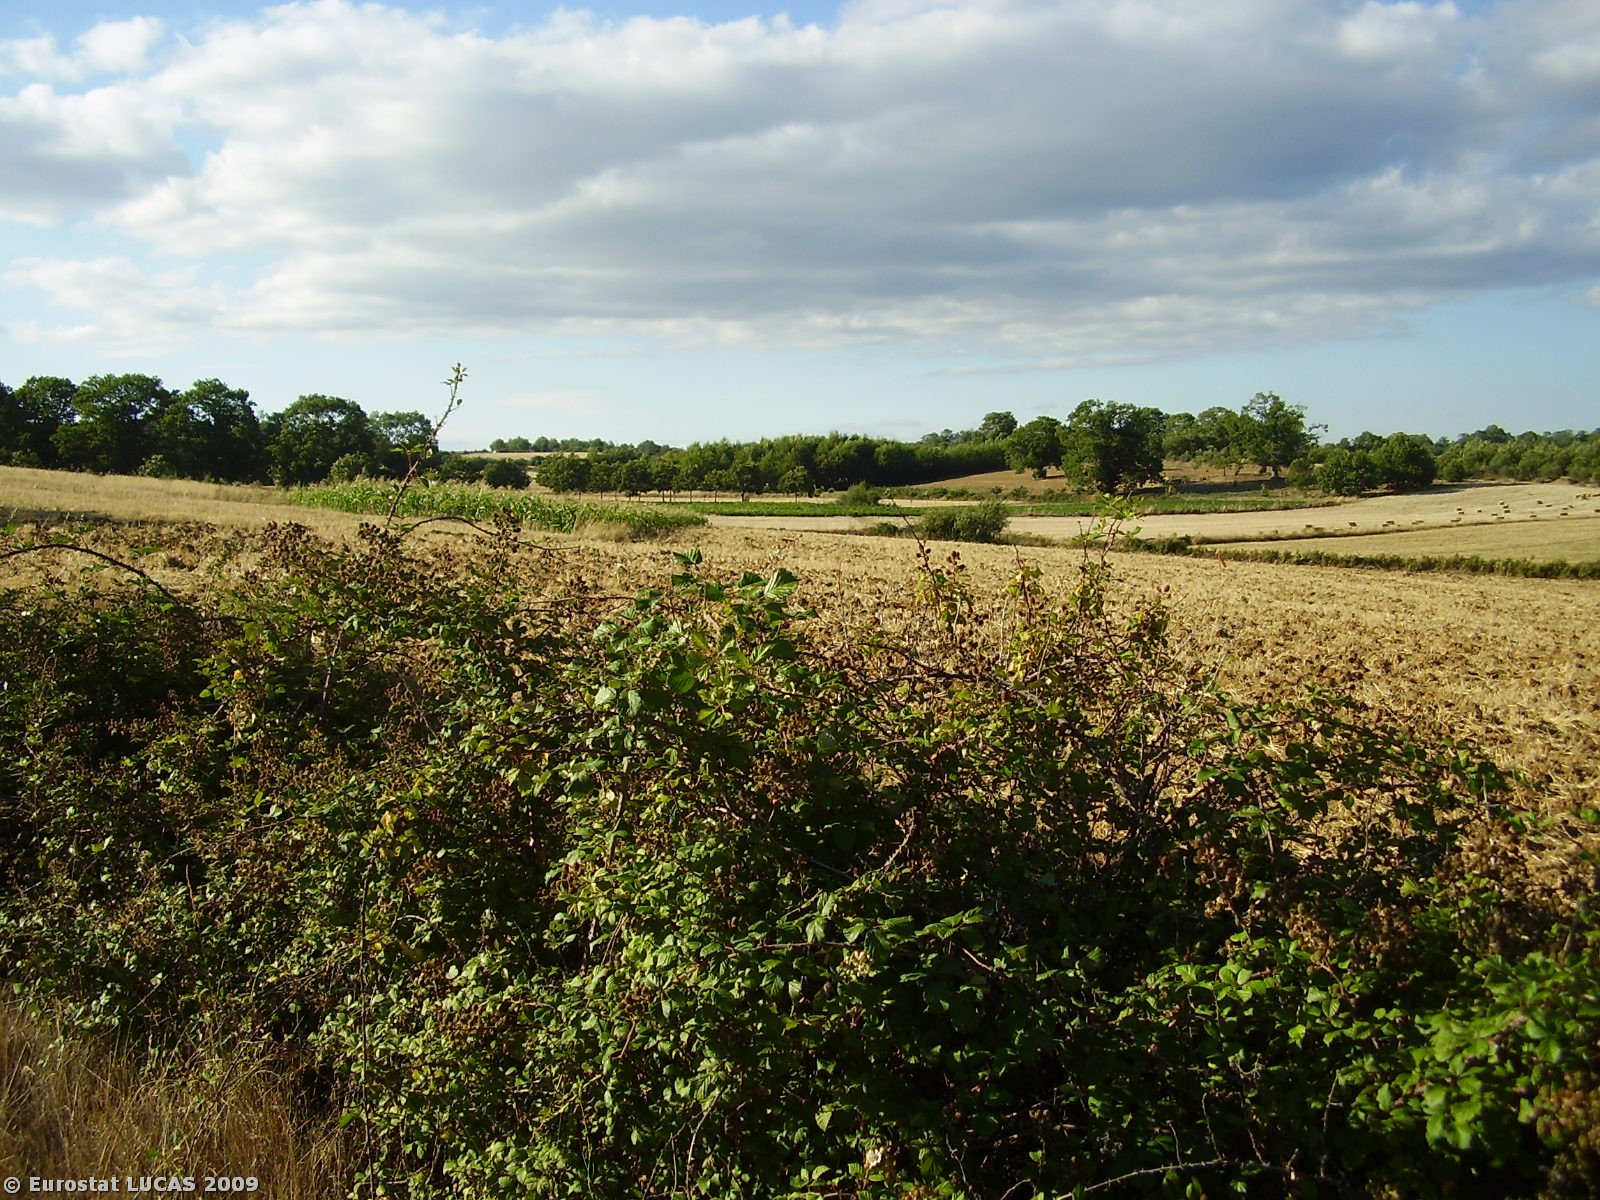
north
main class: Grassland
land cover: Spontaneously vegetated surfaces
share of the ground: > 75 %
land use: Unused
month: July
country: PT
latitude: 41.6887
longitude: -7.3920
